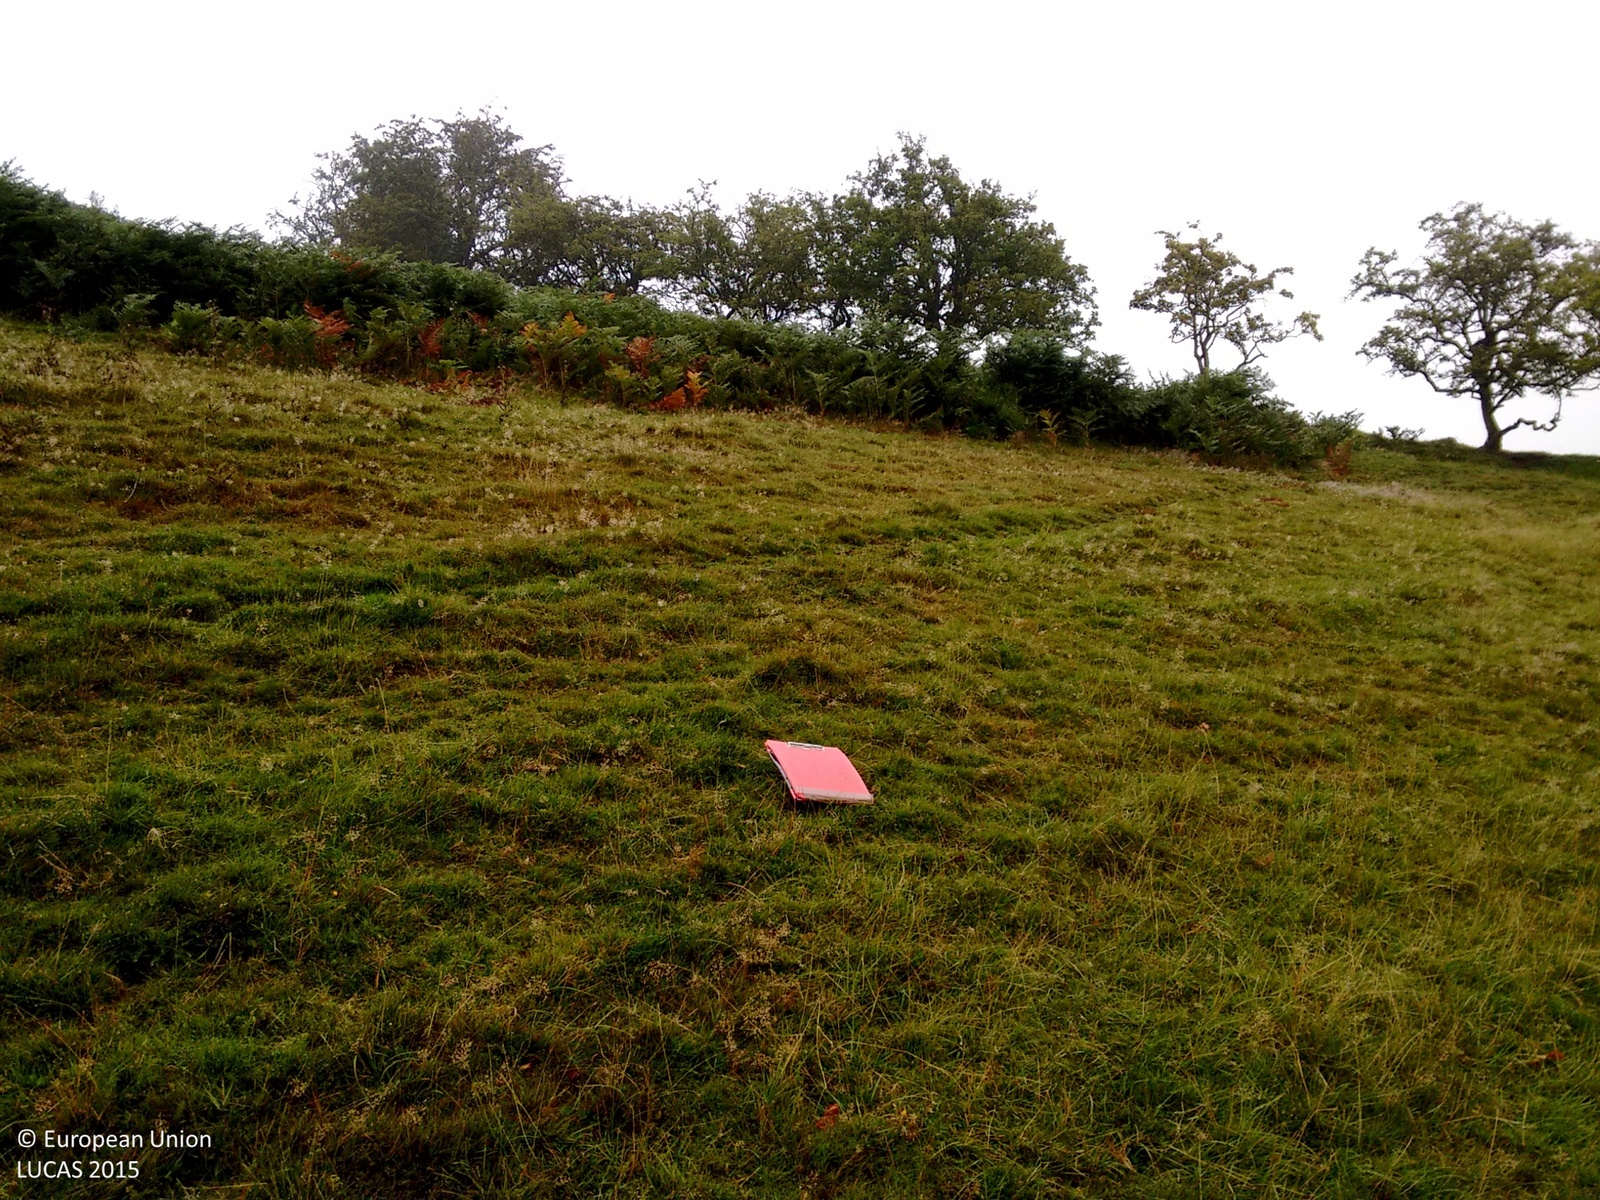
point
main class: Grassland
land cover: Grassland without tree/shrub cover
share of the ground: > 75 %
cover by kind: herbaceous plants 100 %
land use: Agriculture (excluding fallow land and kitchen gardens)
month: September
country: GB
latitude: 52.5633
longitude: -2.8925
